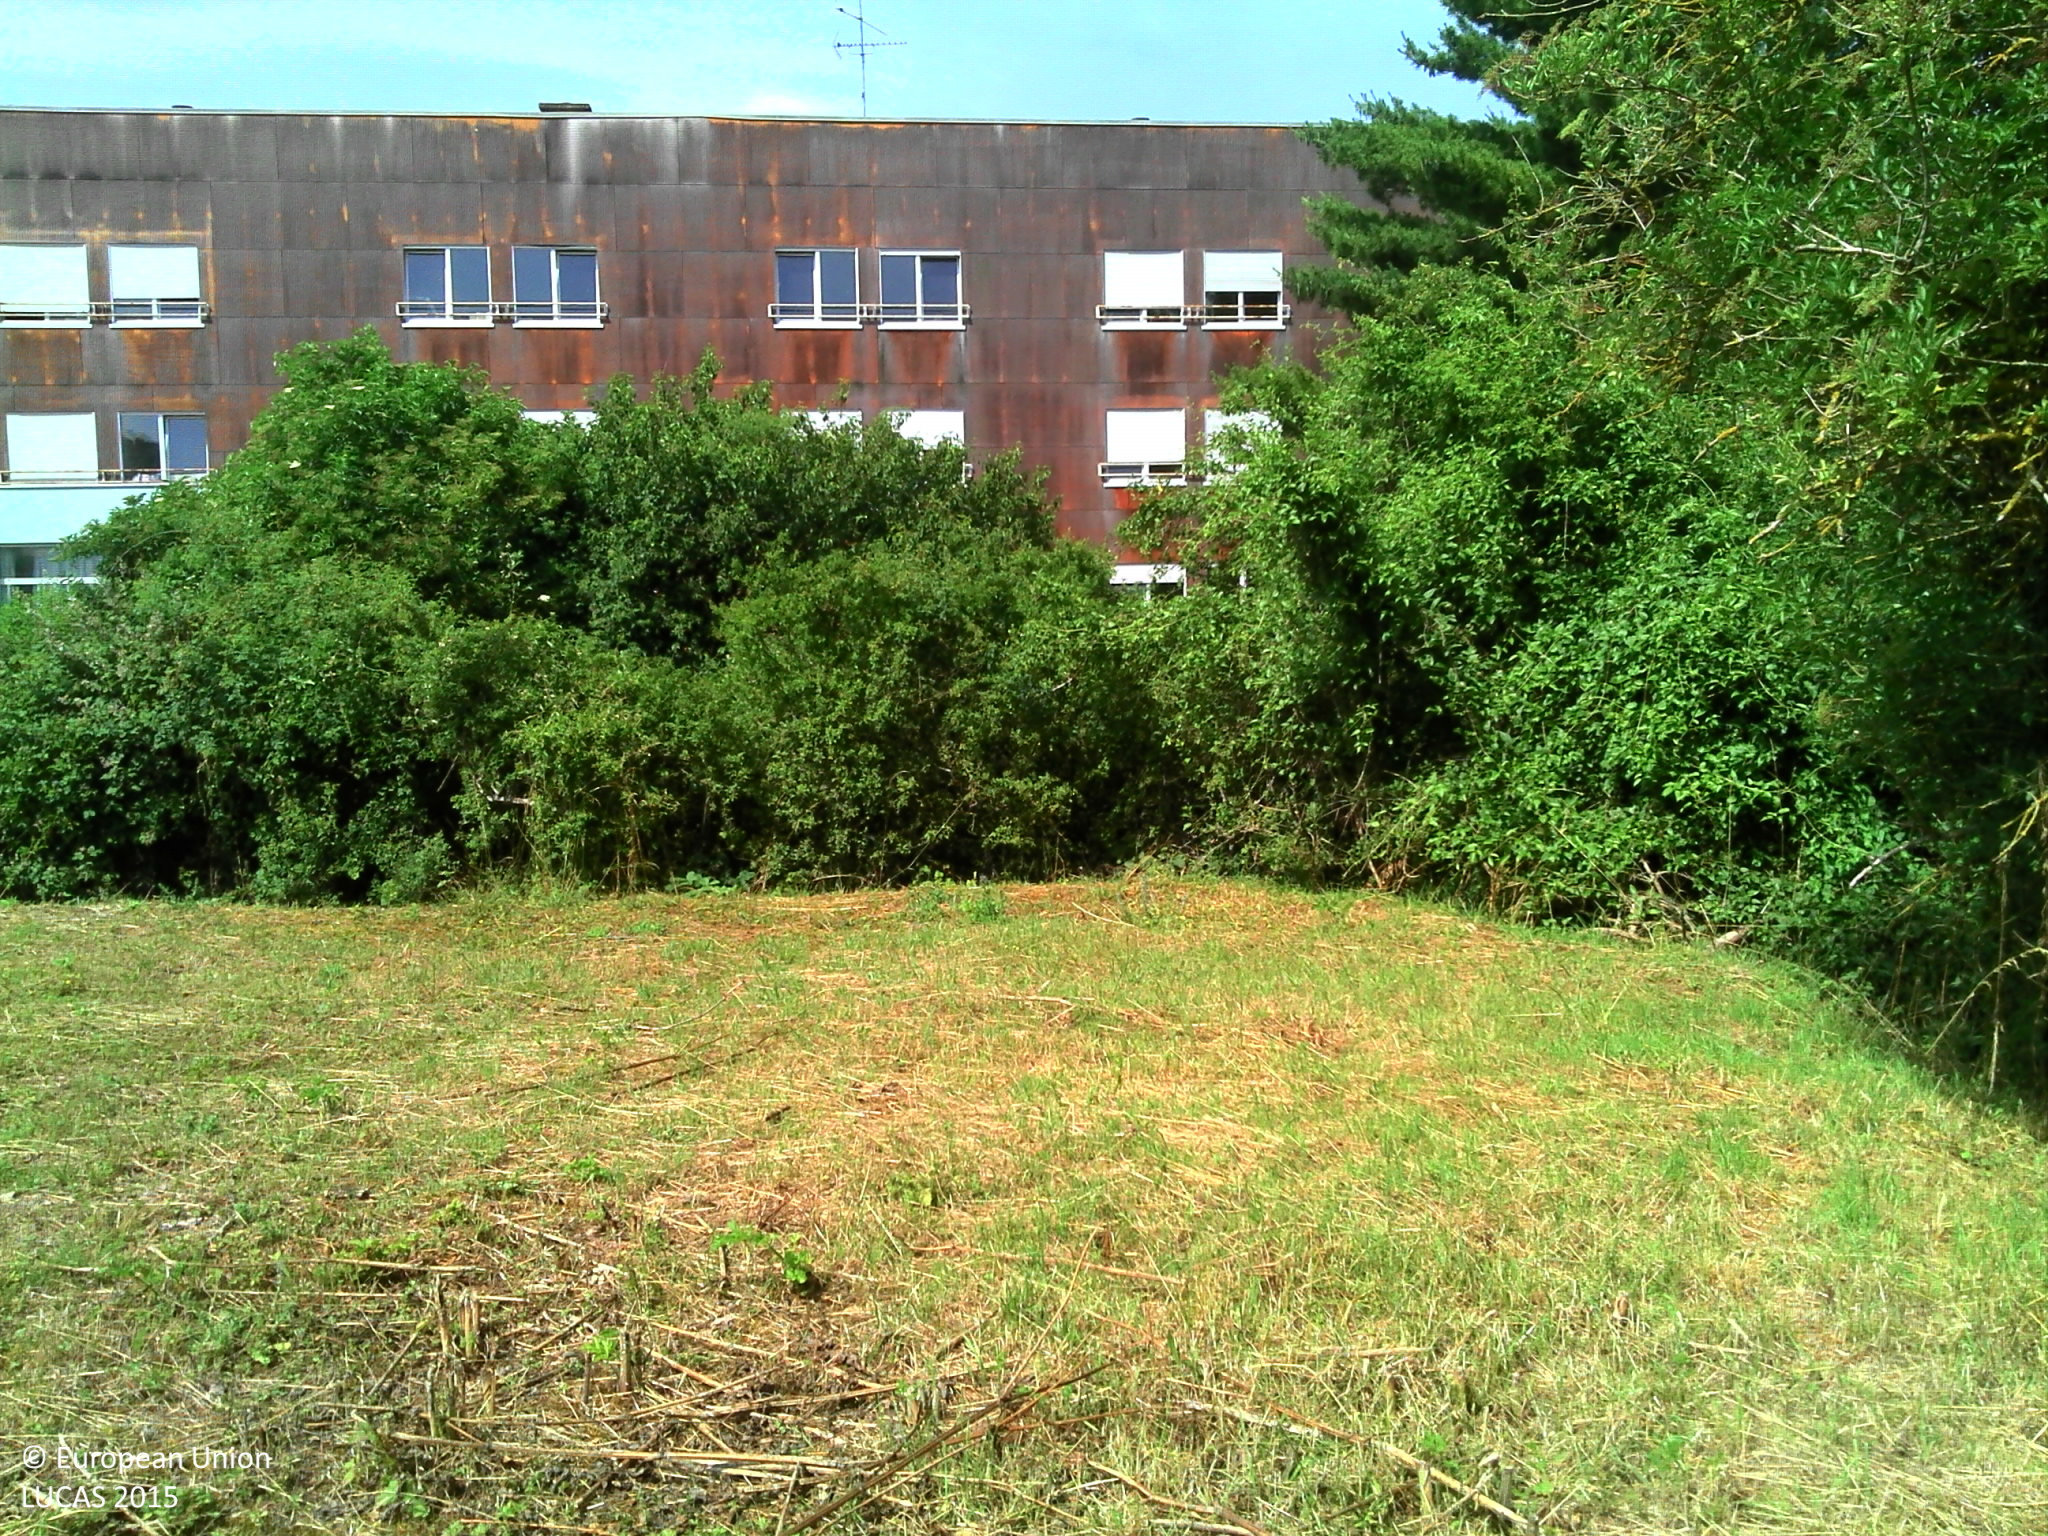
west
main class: Grassland
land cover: Grassland without tree/shrub cover
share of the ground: > 75 %
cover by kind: herbaceous plants 100 %
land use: Community services
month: June
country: FR
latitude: 47.4545
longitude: 3.5104
